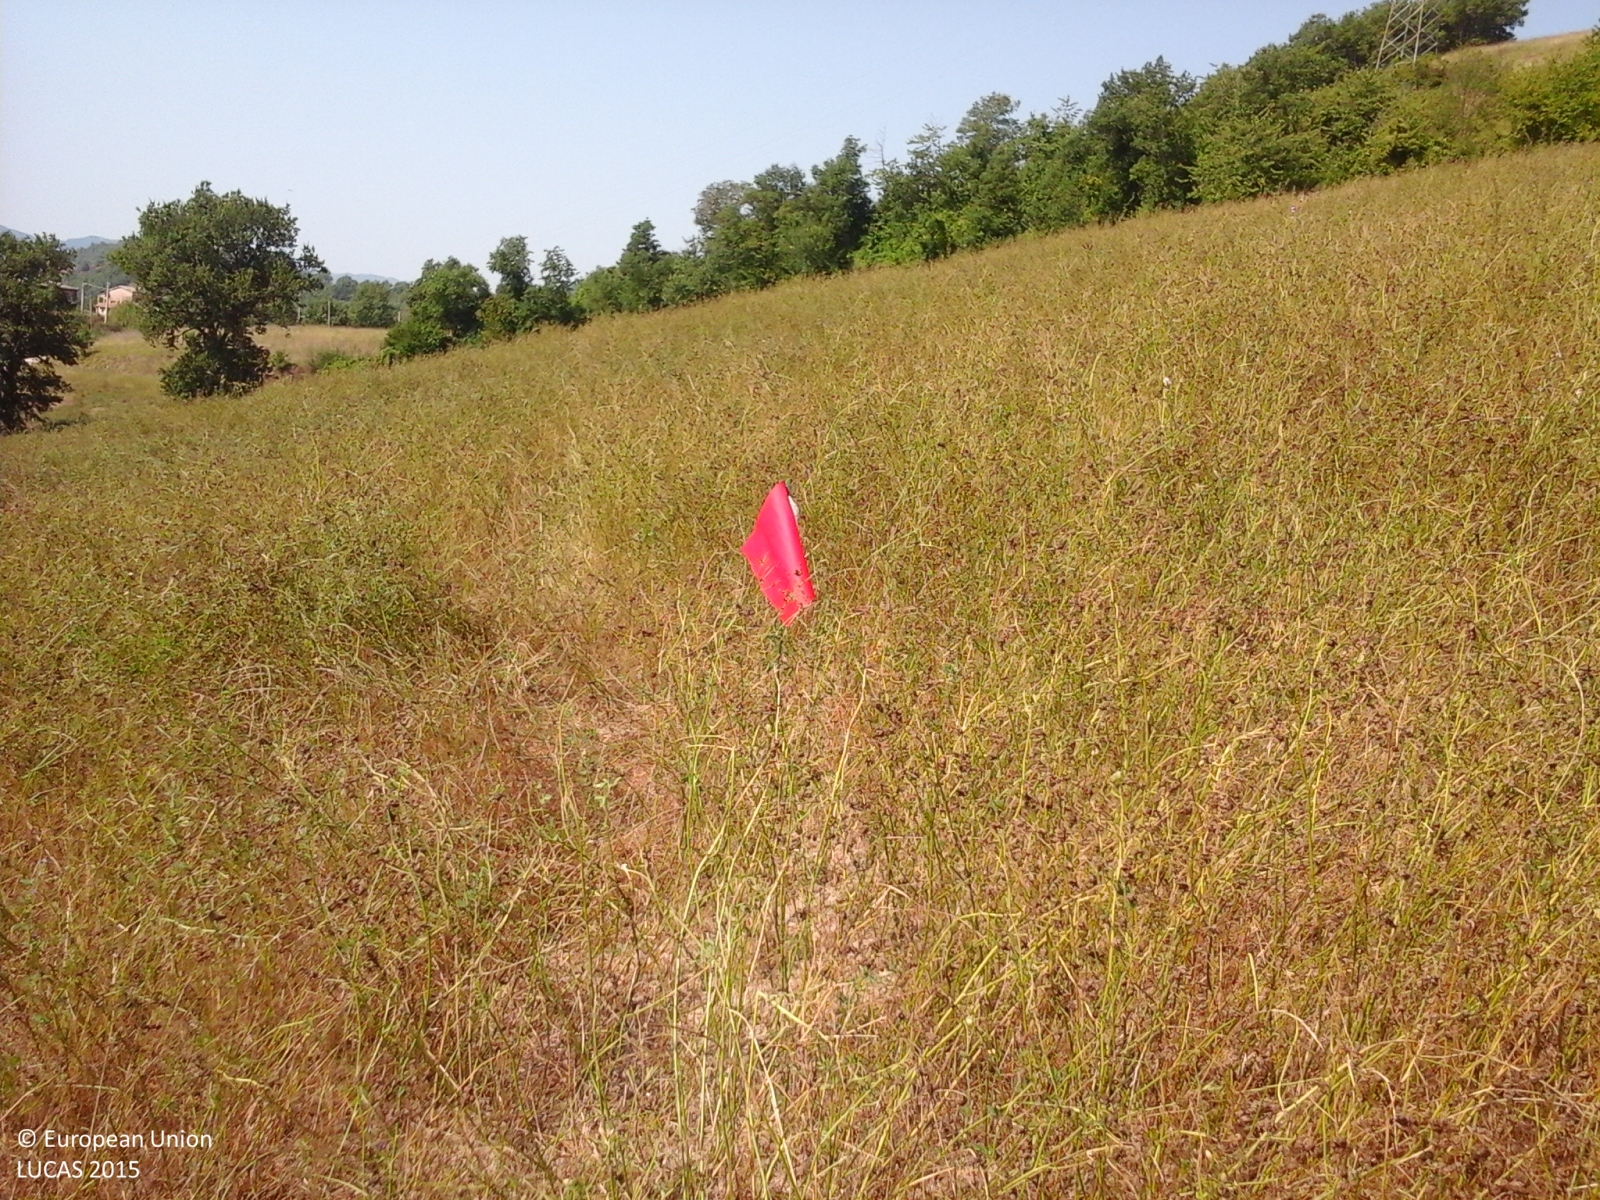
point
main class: Cropland
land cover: Lucerne
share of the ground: > 75 %
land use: Agriculture (excluding fallow land and kitchen gardens)
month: August
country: IT
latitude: 43.6902
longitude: 12.4380
